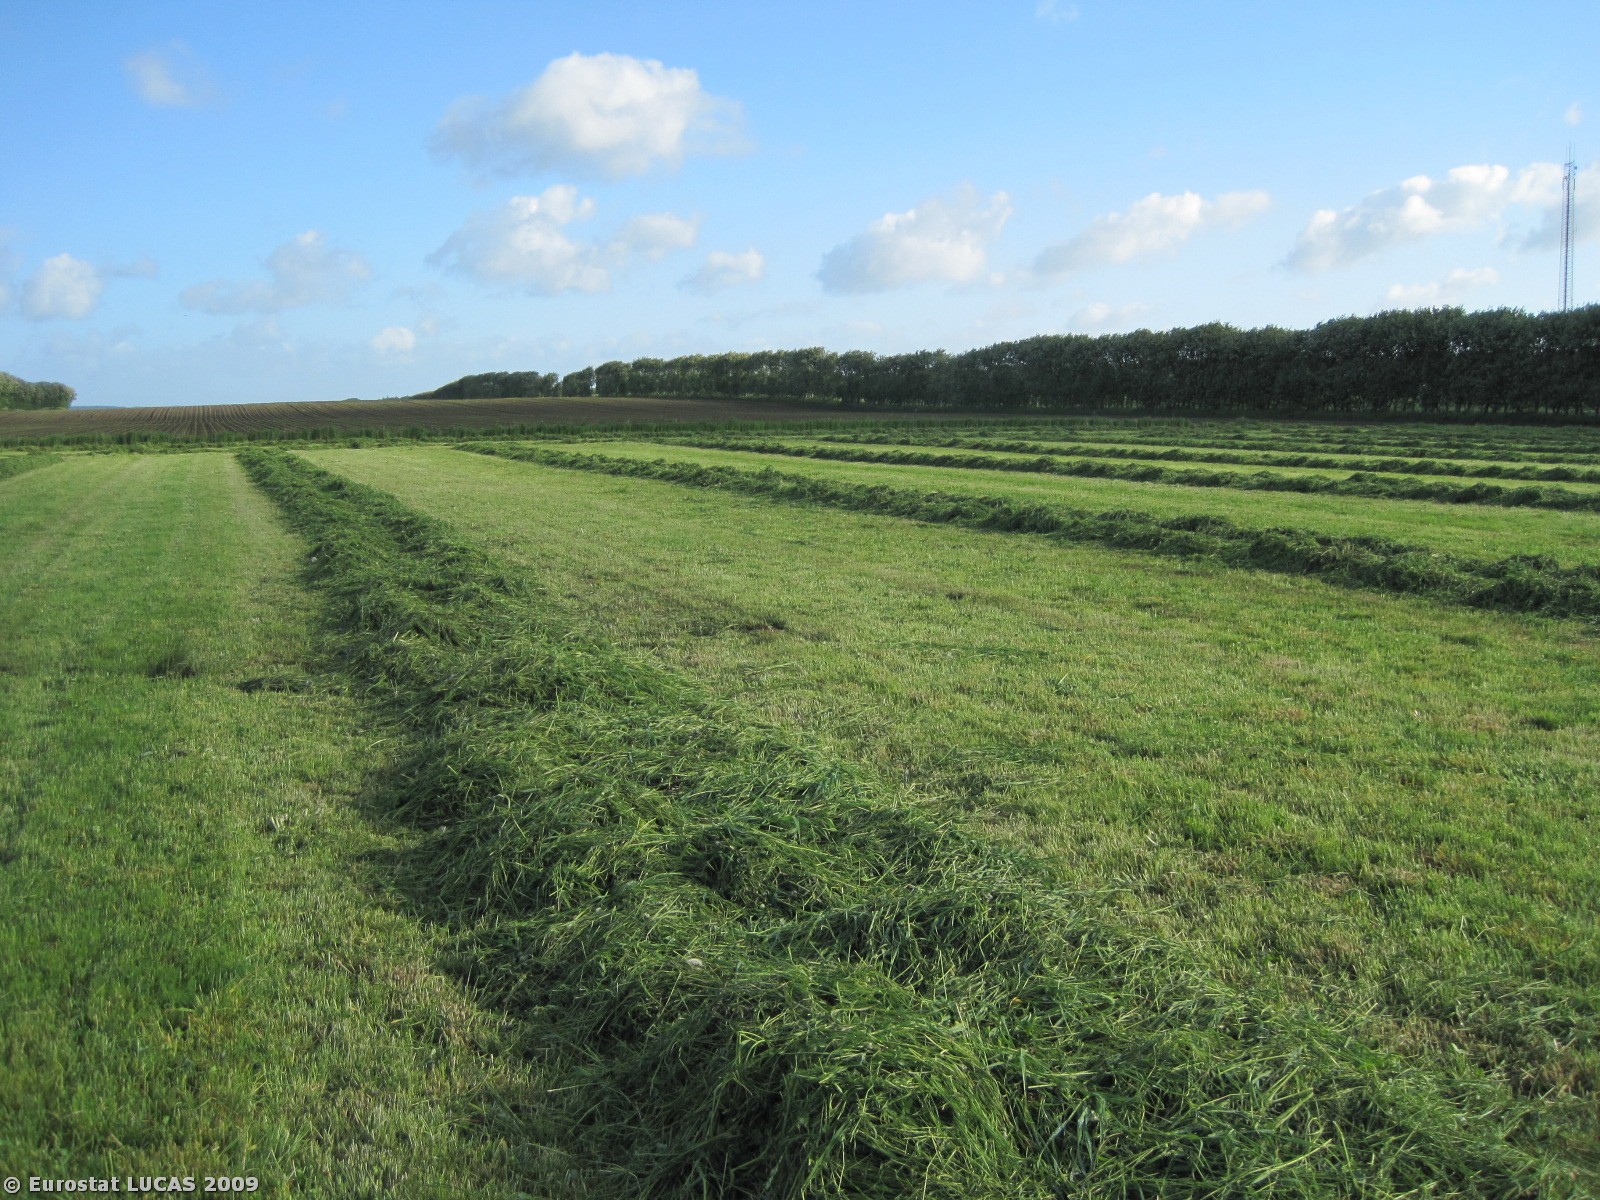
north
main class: Grassland
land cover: Grassland without tree/shrub cover
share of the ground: > 75 %
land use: Agriculture (excluding fallow land and kitchen gardens)
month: May
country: DK
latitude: 56.5111
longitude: 9.7566
